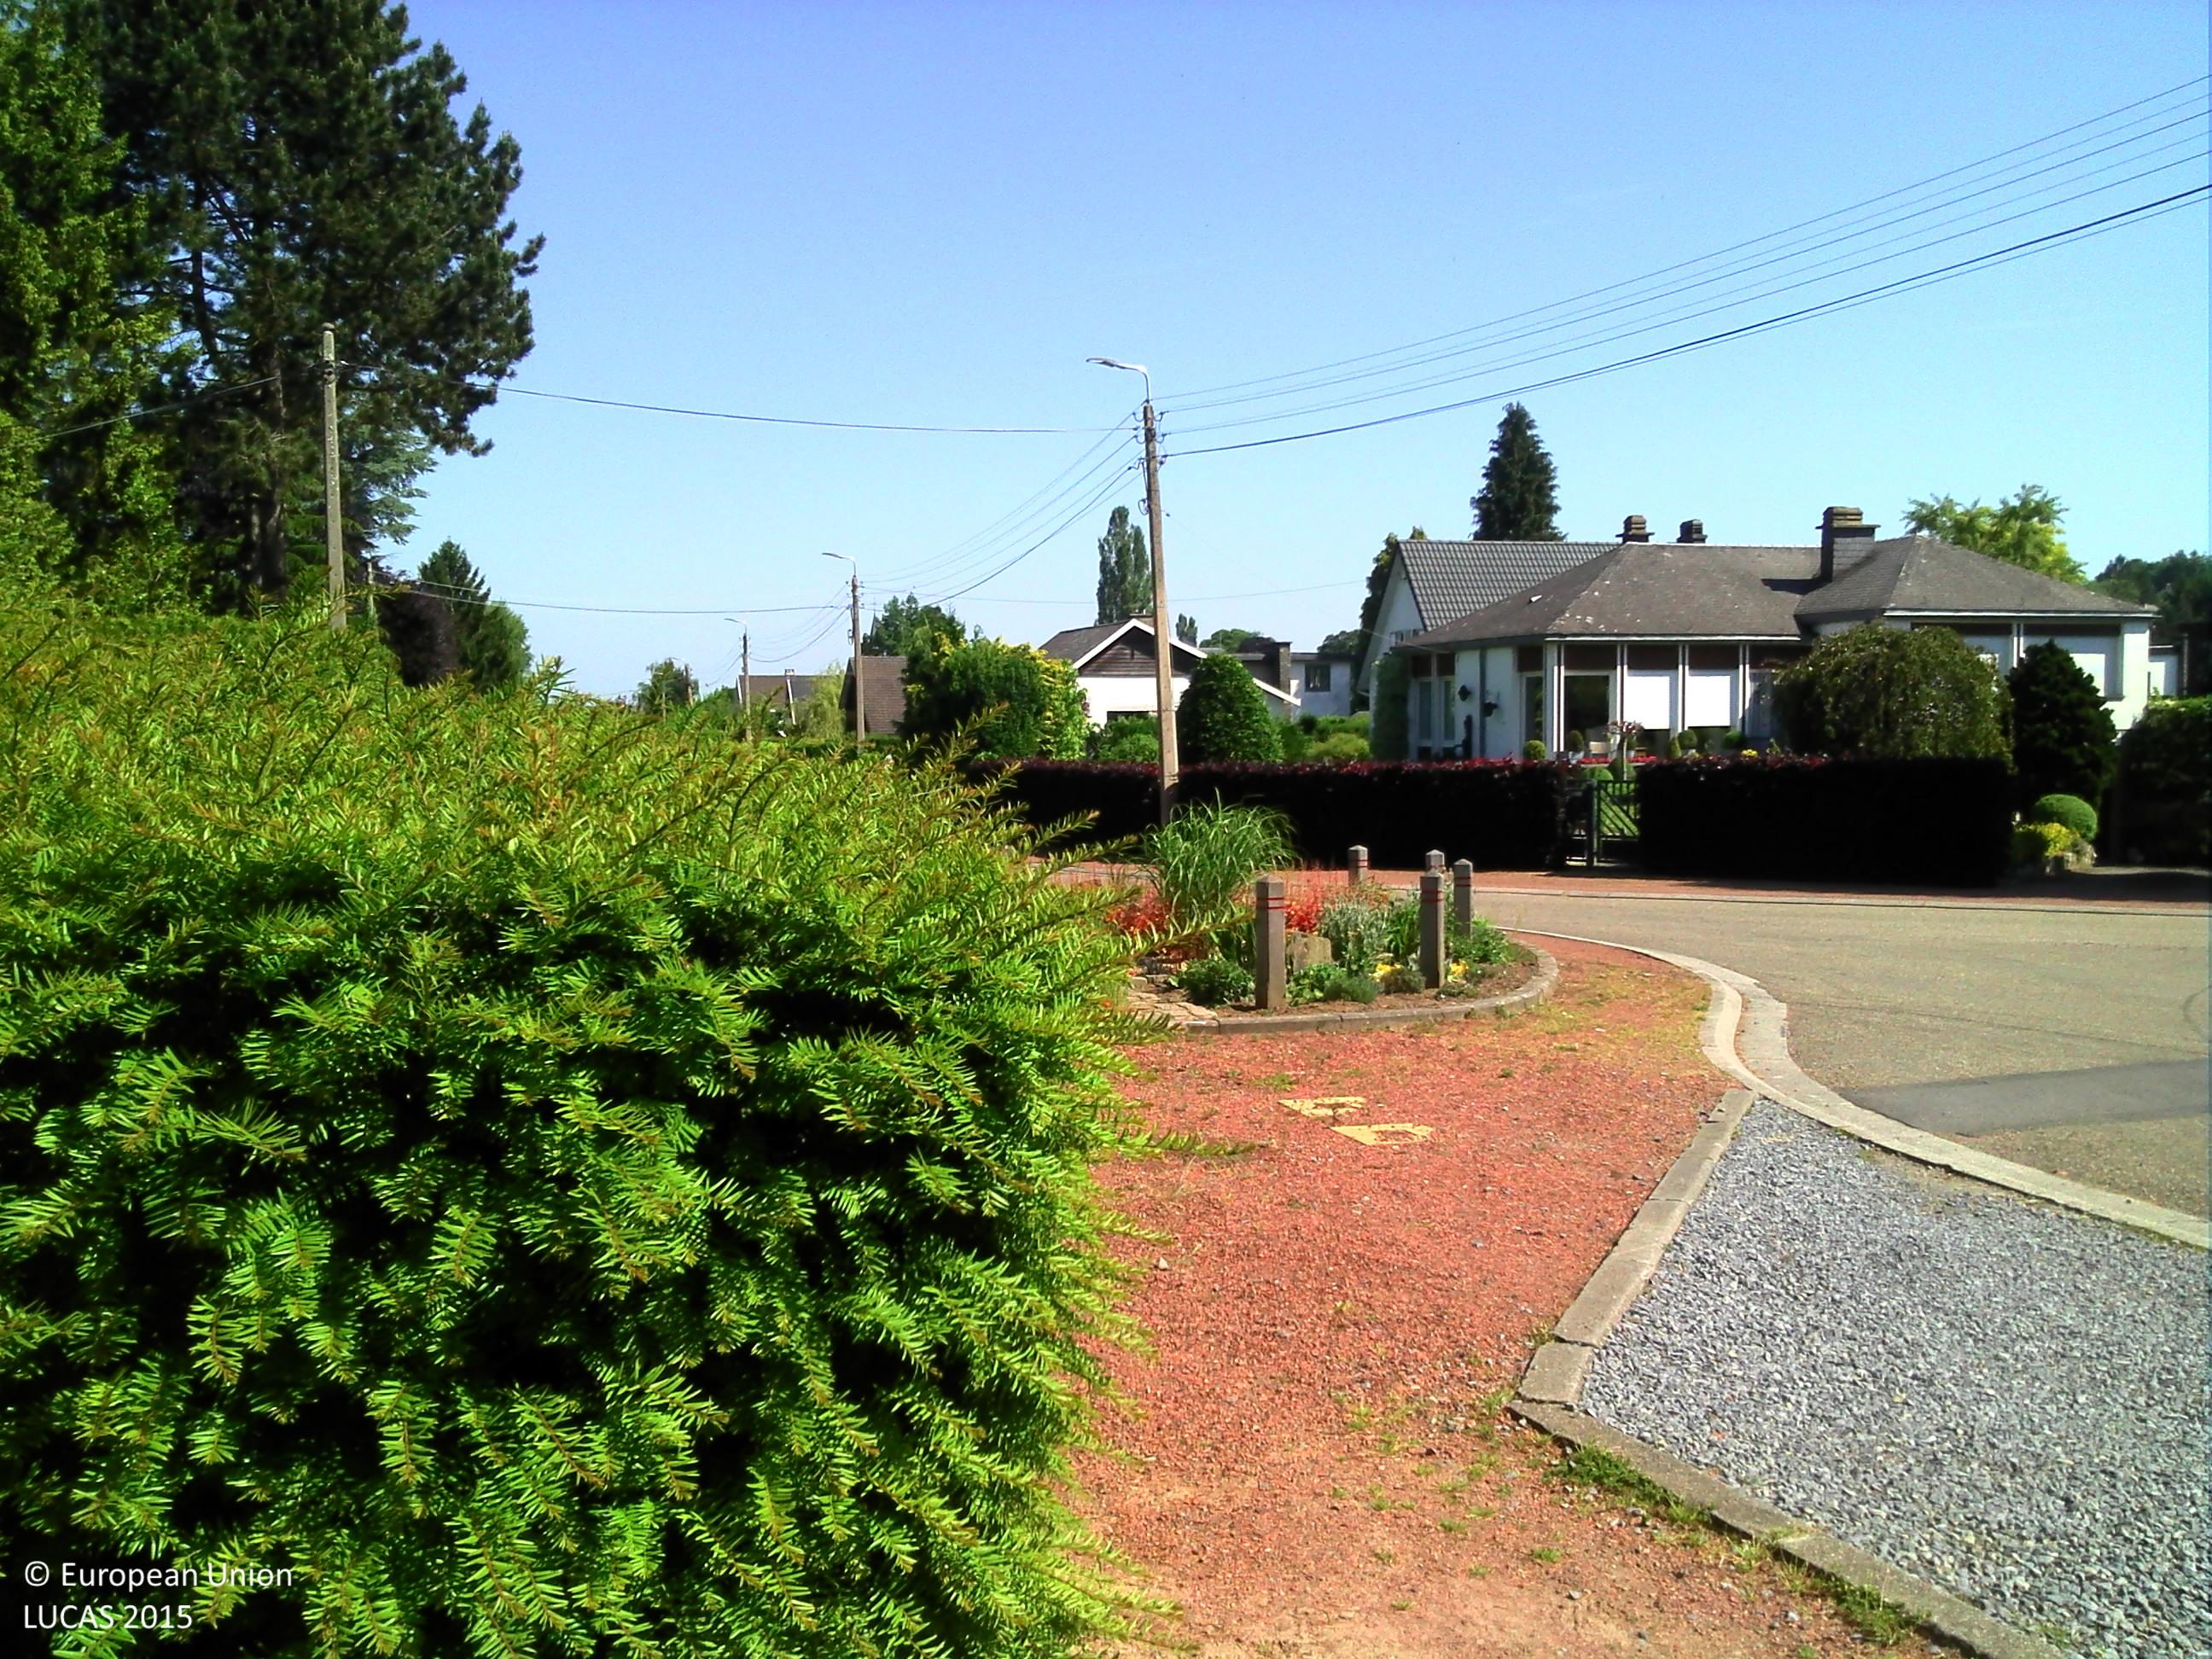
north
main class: Grassland
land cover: Grassland without tree/shrub cover
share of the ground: > 75 %
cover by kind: herbaceous plants 100 %
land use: Residential
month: June
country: BE
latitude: 50.5858
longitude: 5.6058
